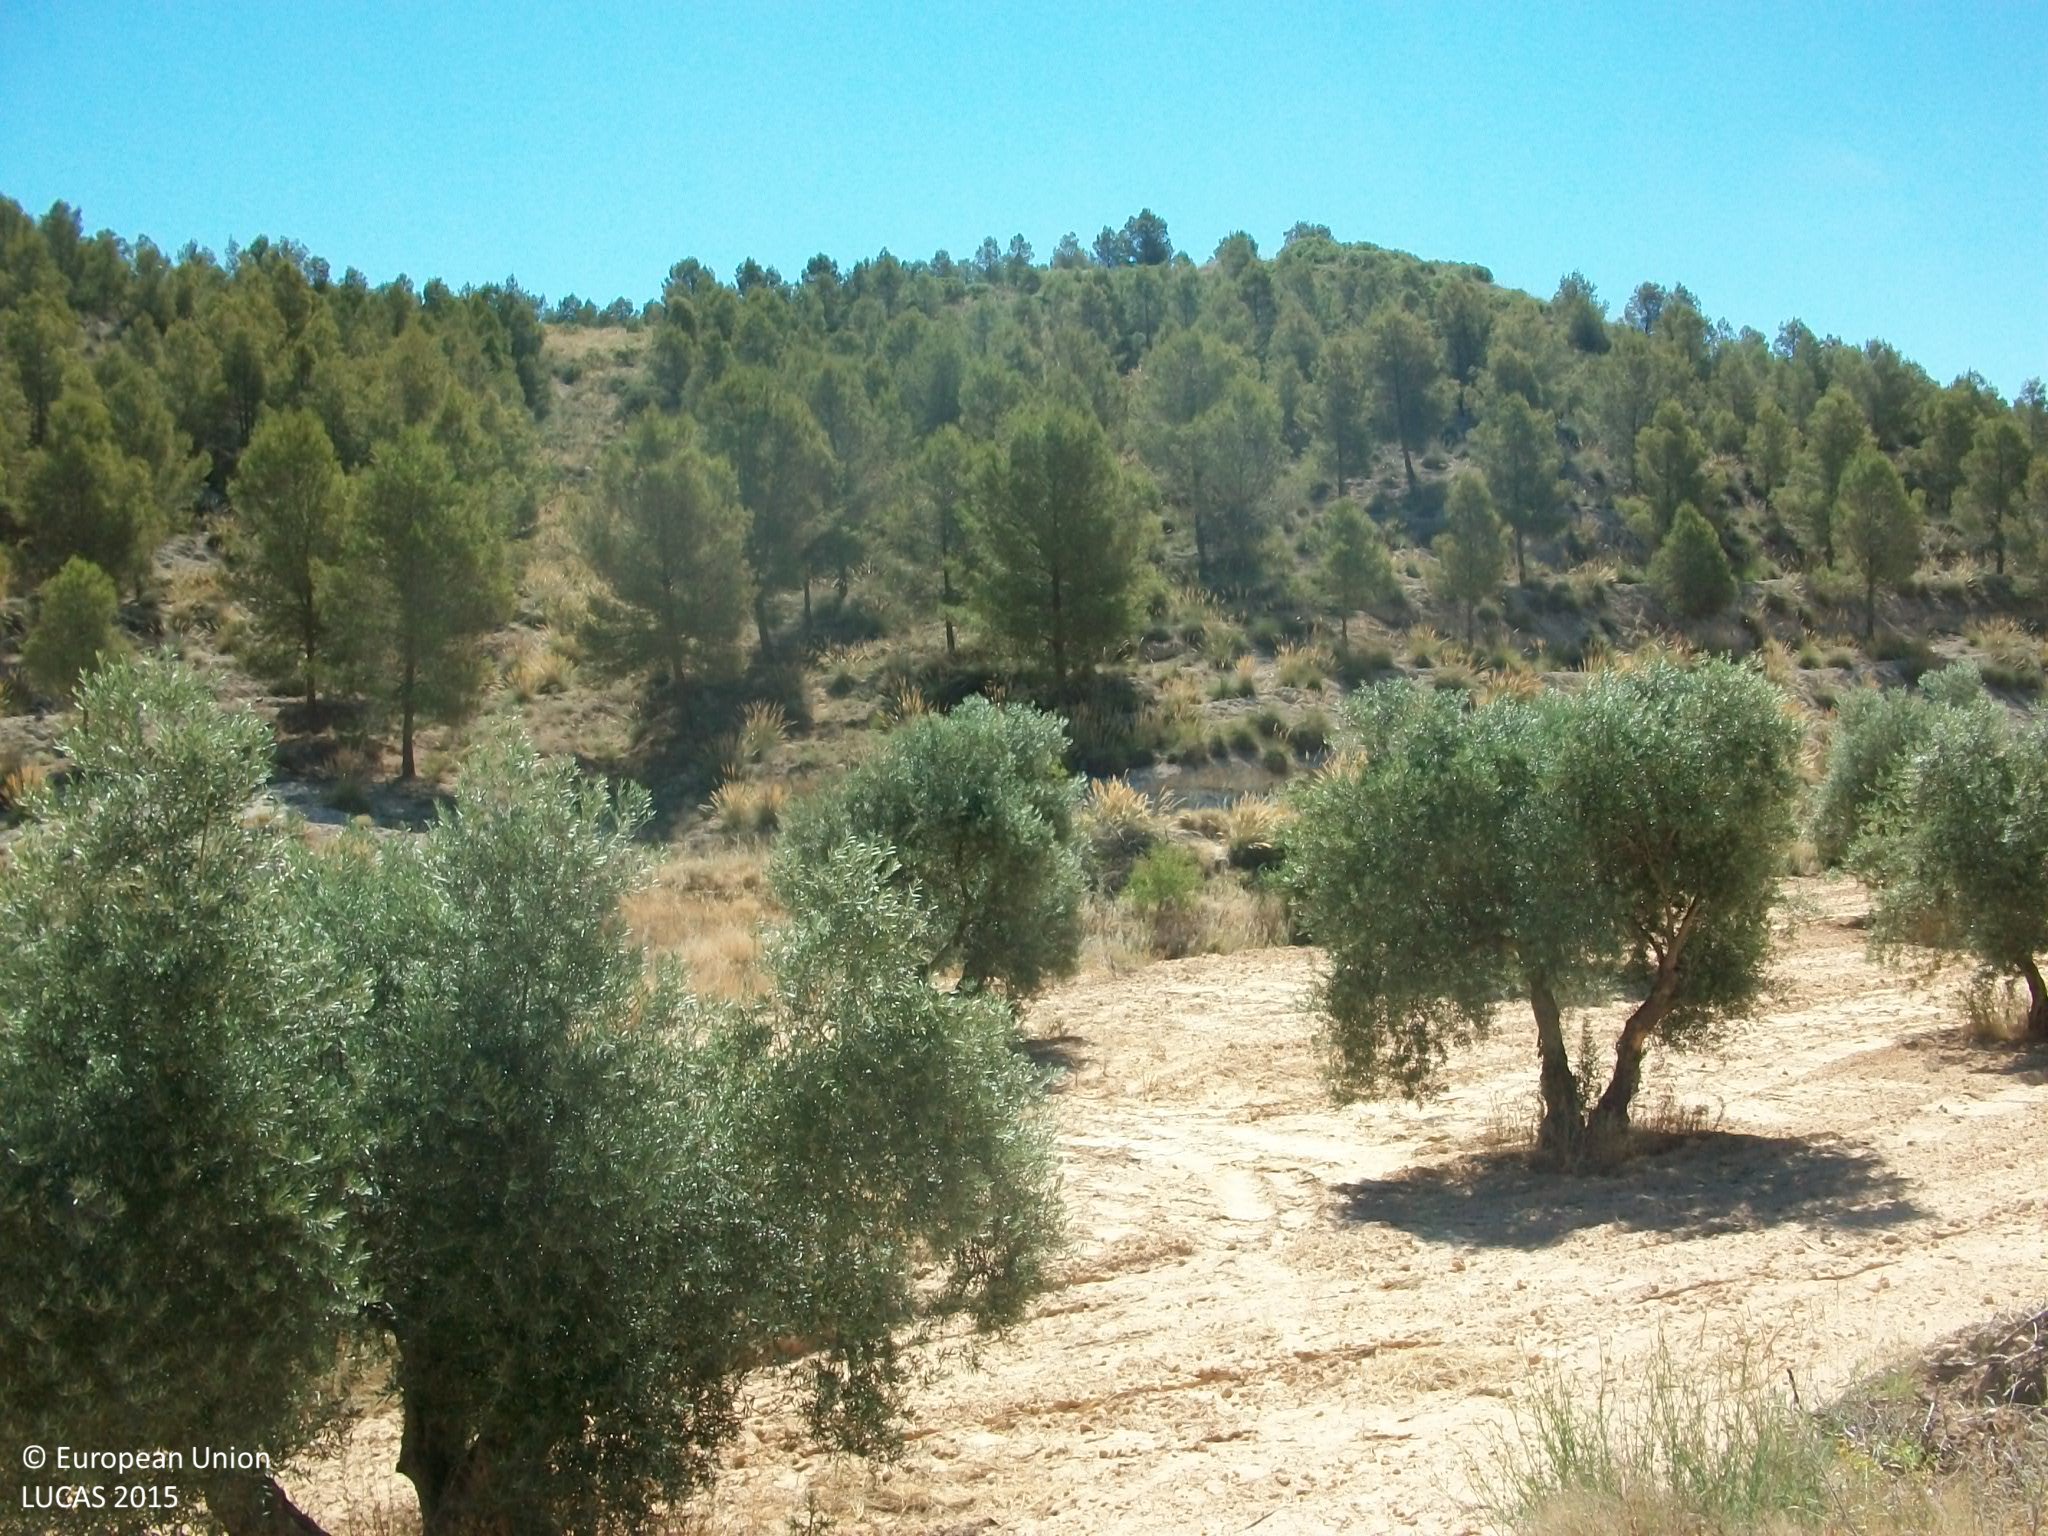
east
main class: Cropland
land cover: Olive groves
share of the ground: 25 - 50 %
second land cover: Other bare soil
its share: > 75 %
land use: Agriculture (excluding fallow land and kitchen gardens)
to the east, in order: Olive groves; Other bare soil; Grassland without tree/shrub cover; Tracks; Grass margins; Pine dominated coniferous woodland; Shrubland with sparse tree cover; Pine dominated coniferous woodland
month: June
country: ES
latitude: 39.9230
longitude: -3.7085
